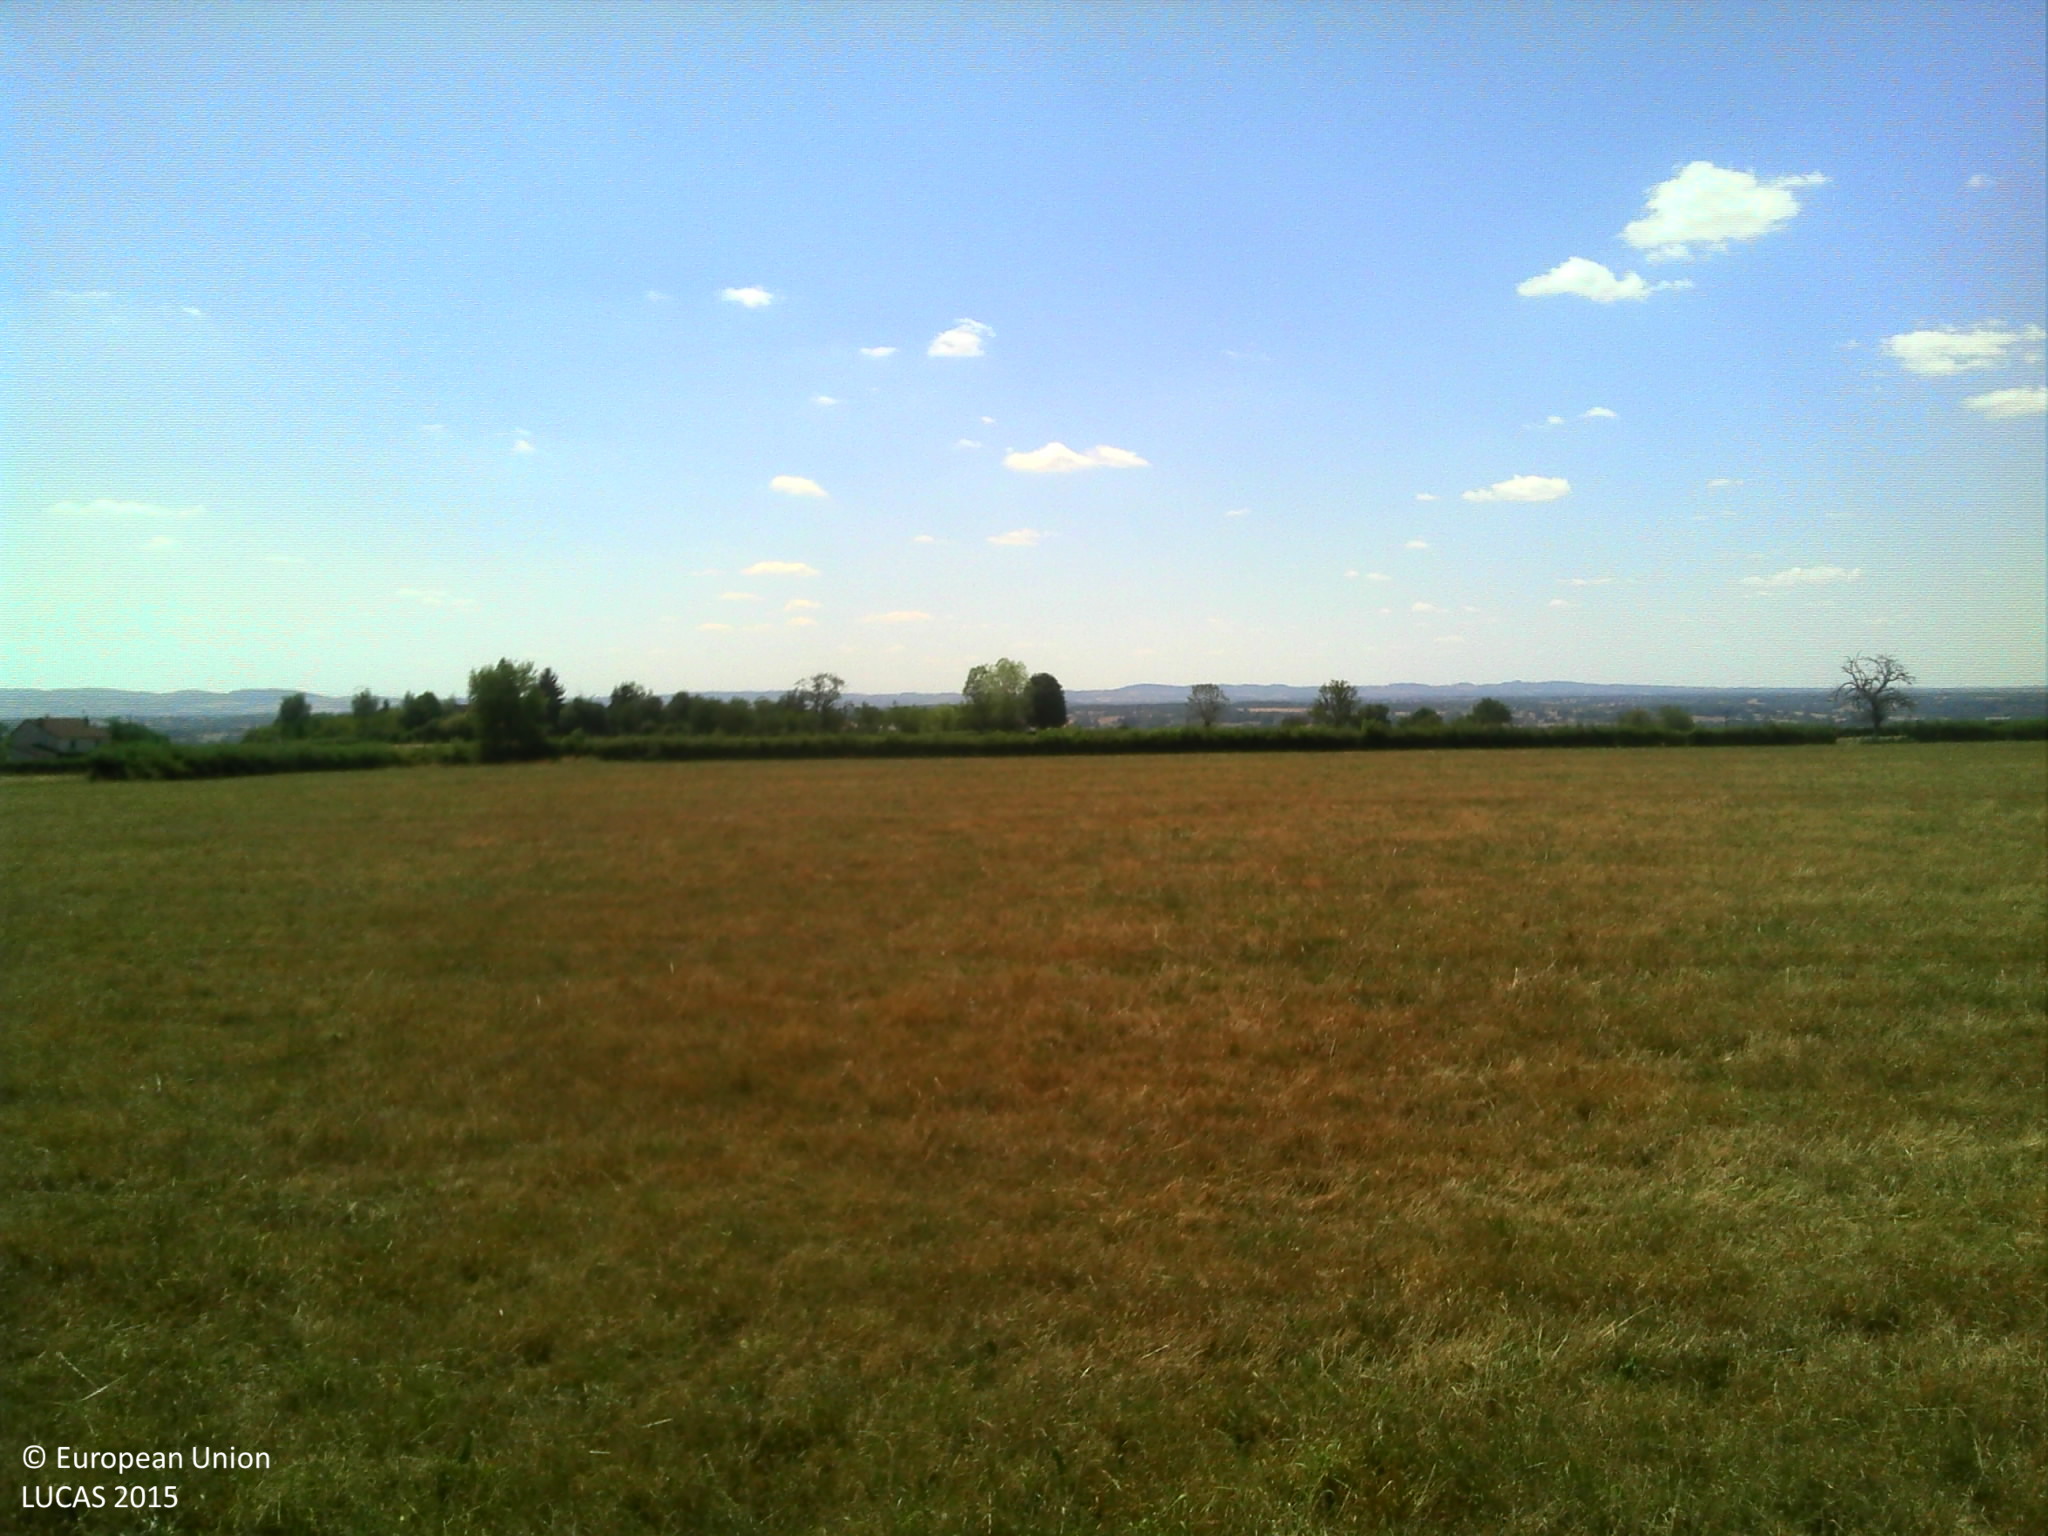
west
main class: Grassland
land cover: Grassland without tree/shrub cover
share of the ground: > 75 %
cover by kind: herbaceous plants 100 %
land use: Agriculture (excluding fallow land and kitchen gardens)
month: July
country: FR
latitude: 46.2770
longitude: 4.0703
